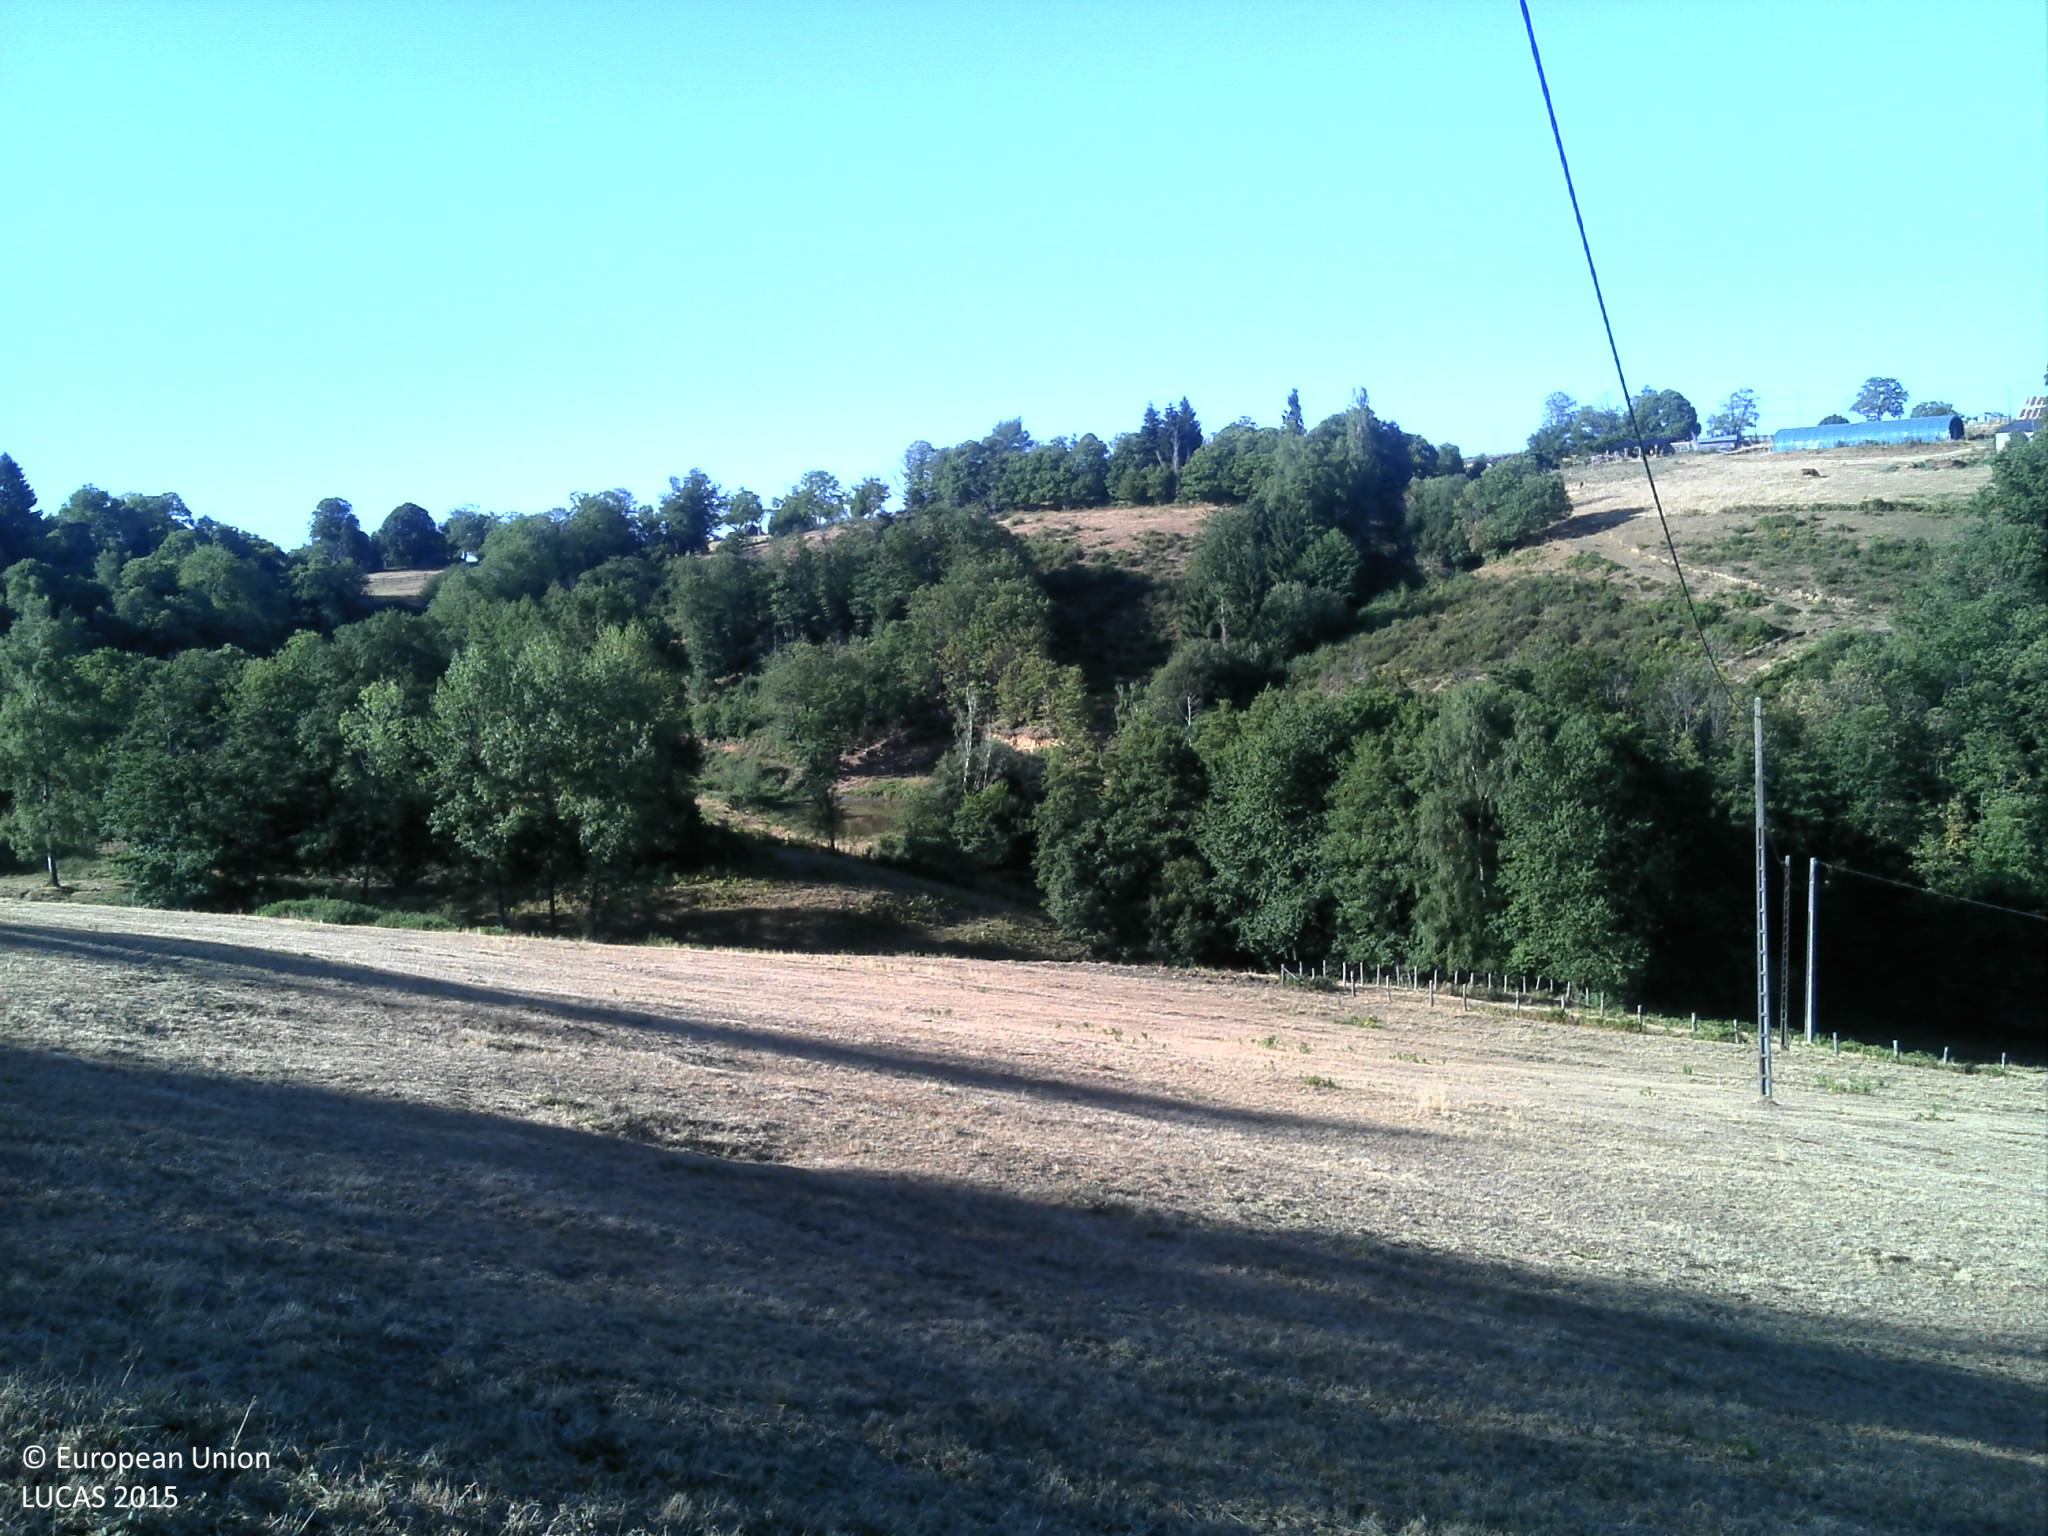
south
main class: Grassland
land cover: Grassland with sparse tree/shrub cover
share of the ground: > 75 %
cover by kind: herbaceous plants 95 %, broadleaved forest trees 5 %
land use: Agriculture (excluding fallow land and kitchen gardens)
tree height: > 5 m
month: July
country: FR
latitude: 45.1085
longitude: 1.7479
